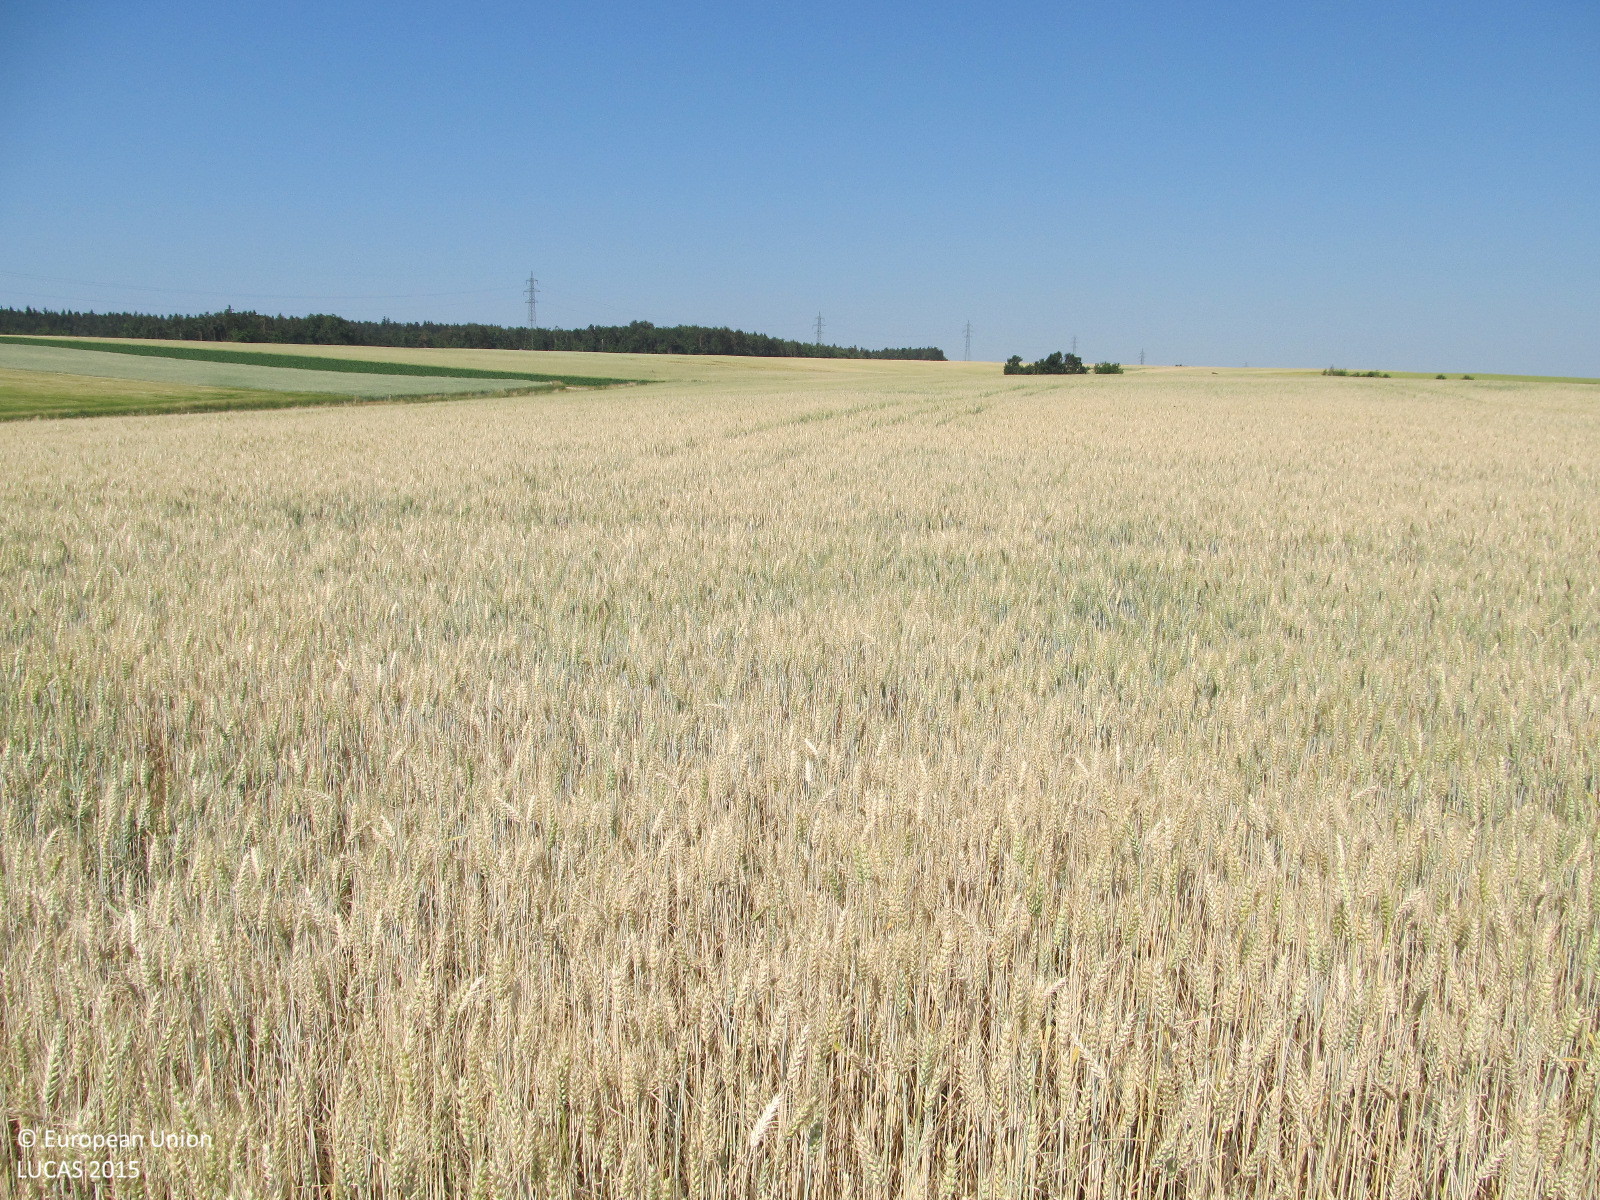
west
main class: Cropland
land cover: Common wheat
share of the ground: > 75 %
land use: Agriculture (excluding fallow land and kitchen gardens)
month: July
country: AT
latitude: 48.7268
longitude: 15.6724
